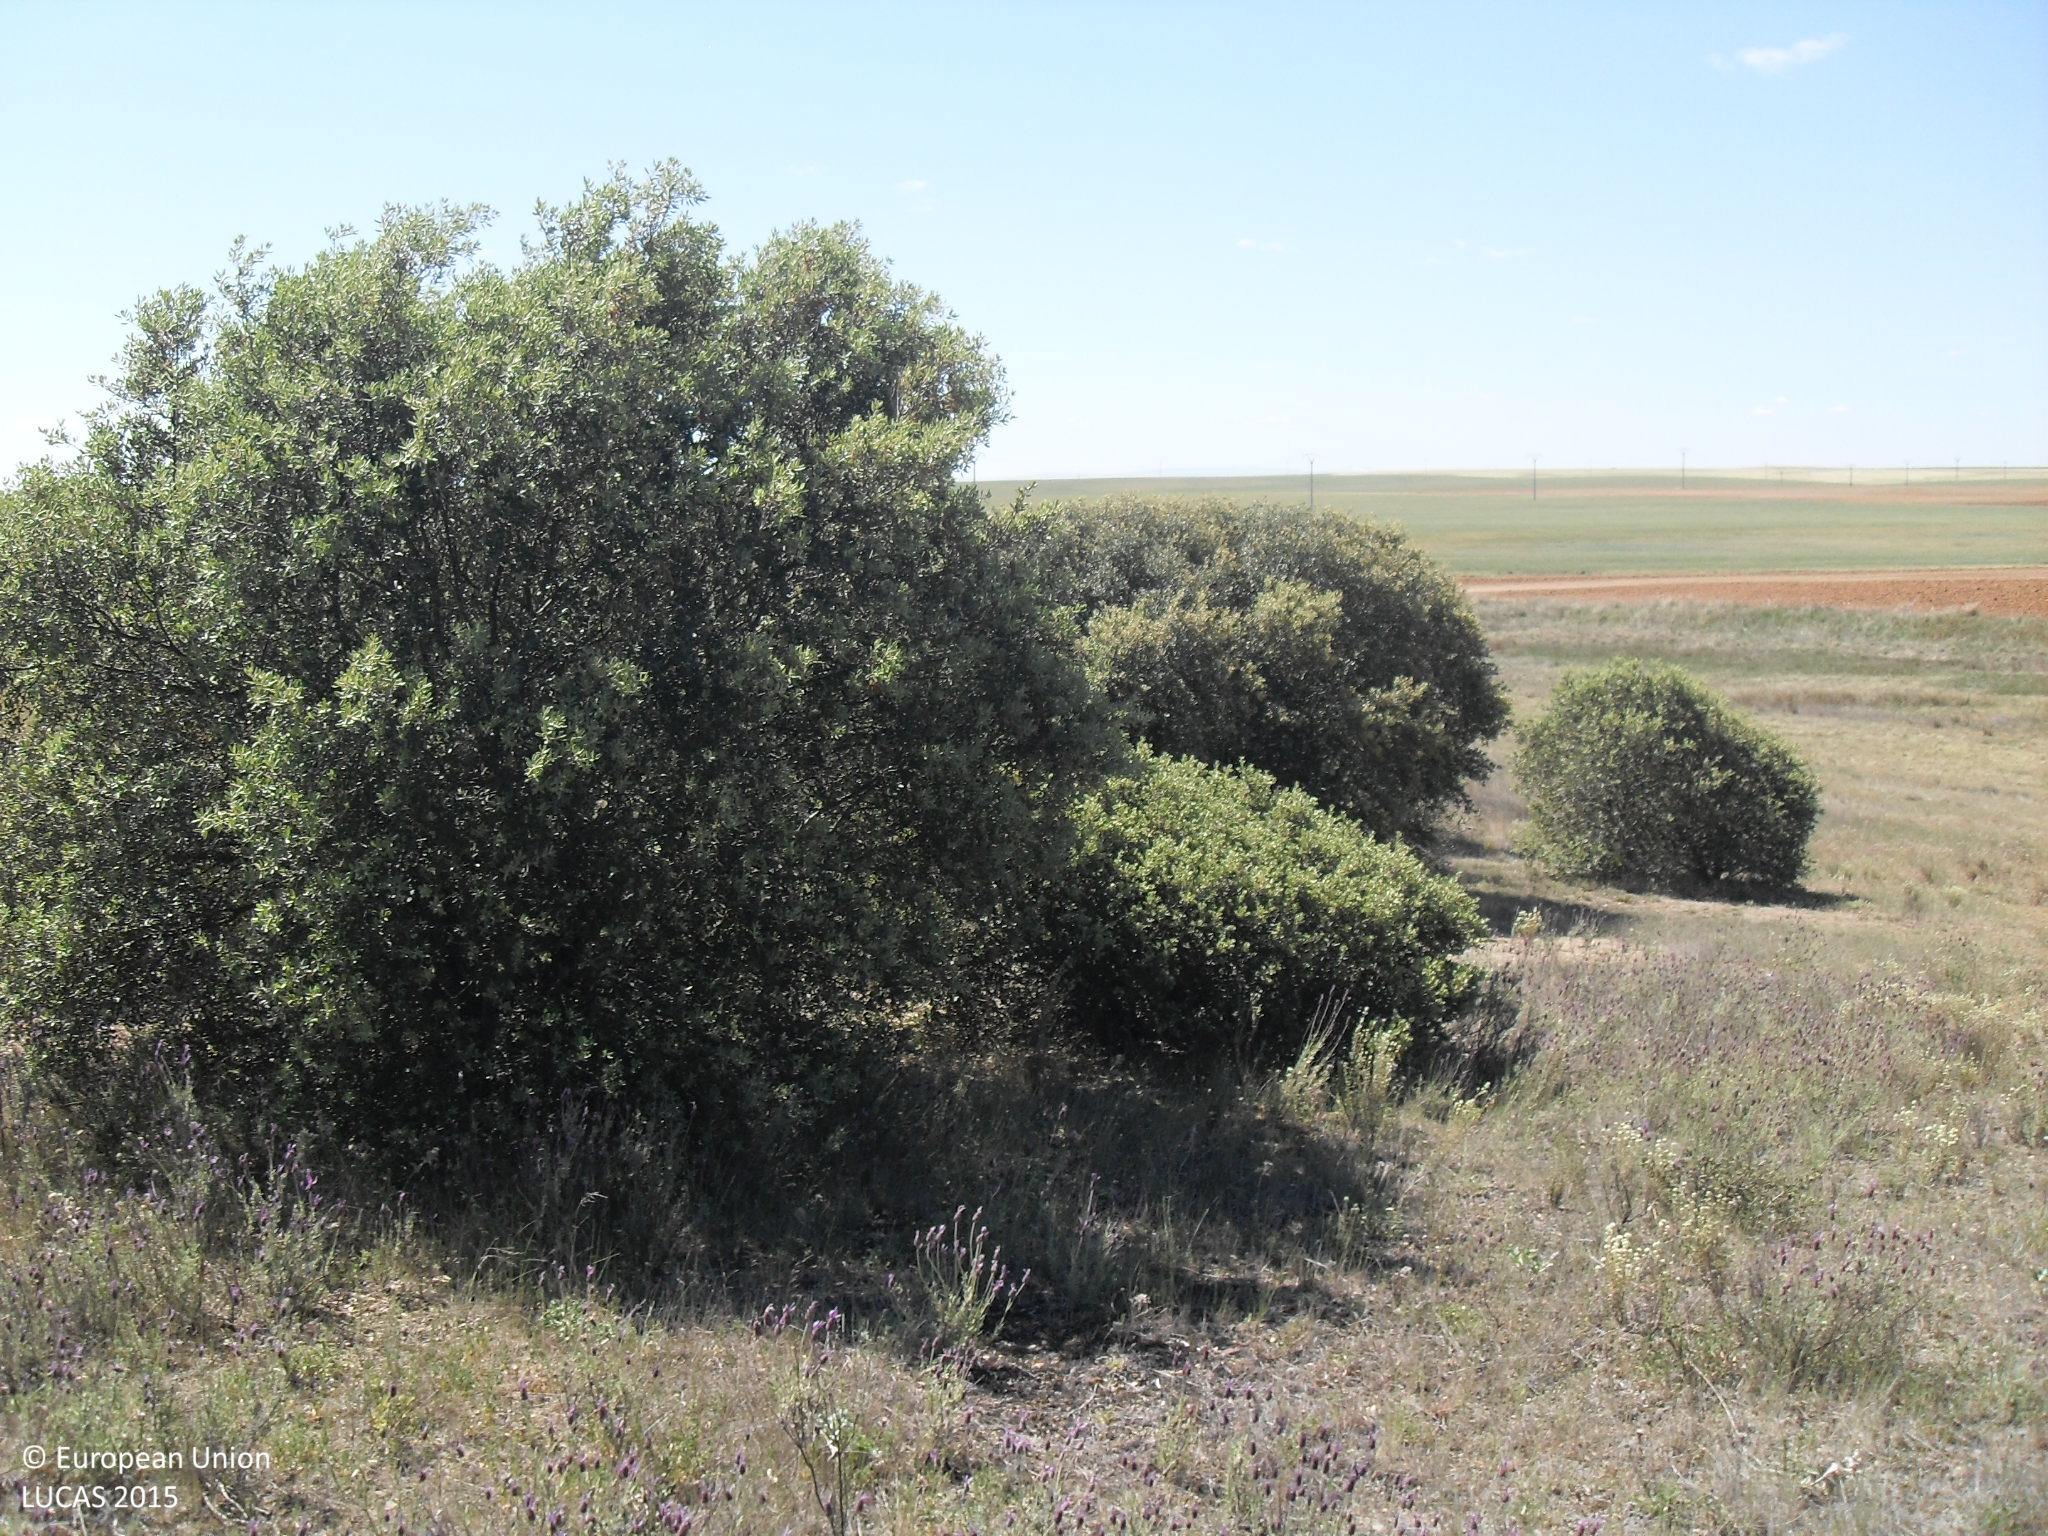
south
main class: Grassland
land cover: Grassland with sparse tree/shrub cover
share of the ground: > 75 %
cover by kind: herbaceous plants 85 %, shrubs 10 %, broadleaved forest trees 5 %
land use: Agriculture (excluding fallow land and kitchen gardens)
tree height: < 5 m
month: May
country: ES
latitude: 41.1159
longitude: -5.3046
